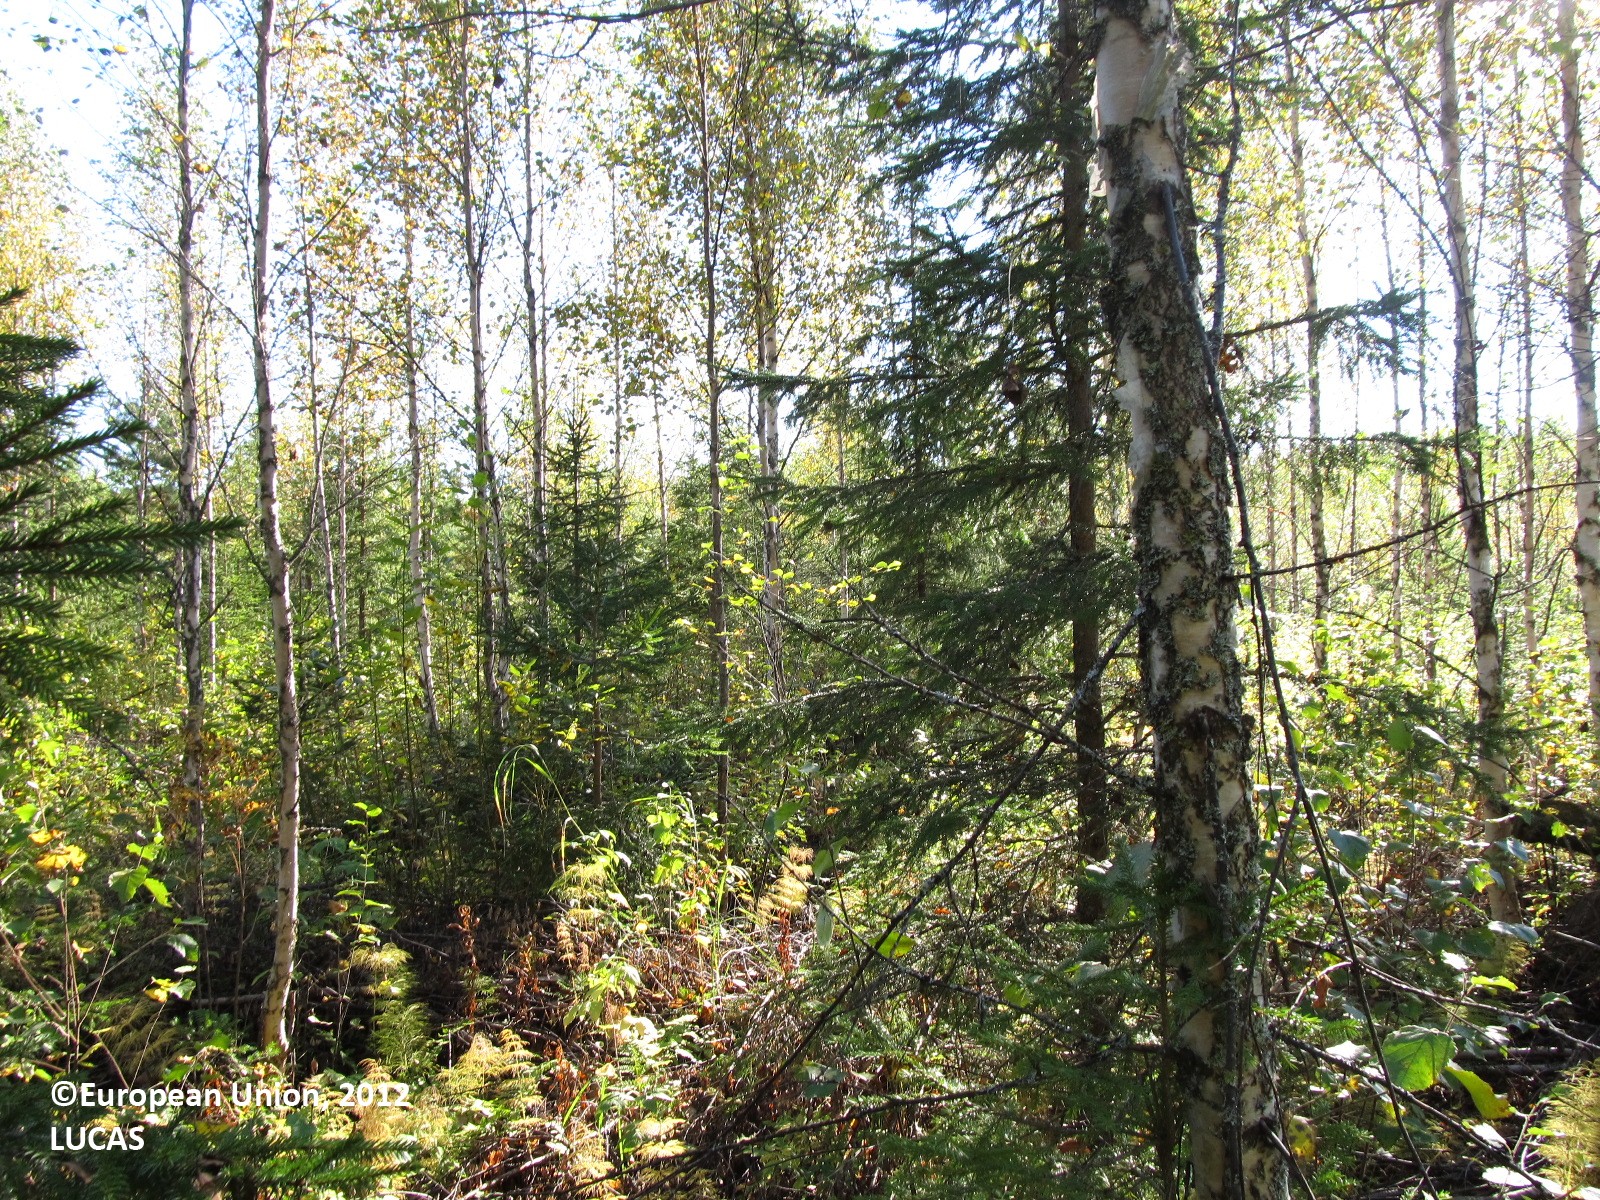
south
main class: Woodland
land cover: Spruce dominated mixed woodland
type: boreal forest
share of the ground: 50 - 75 %
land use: Forestry
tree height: > 5 m
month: September
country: FI
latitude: 62.4412
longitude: 28.3102
